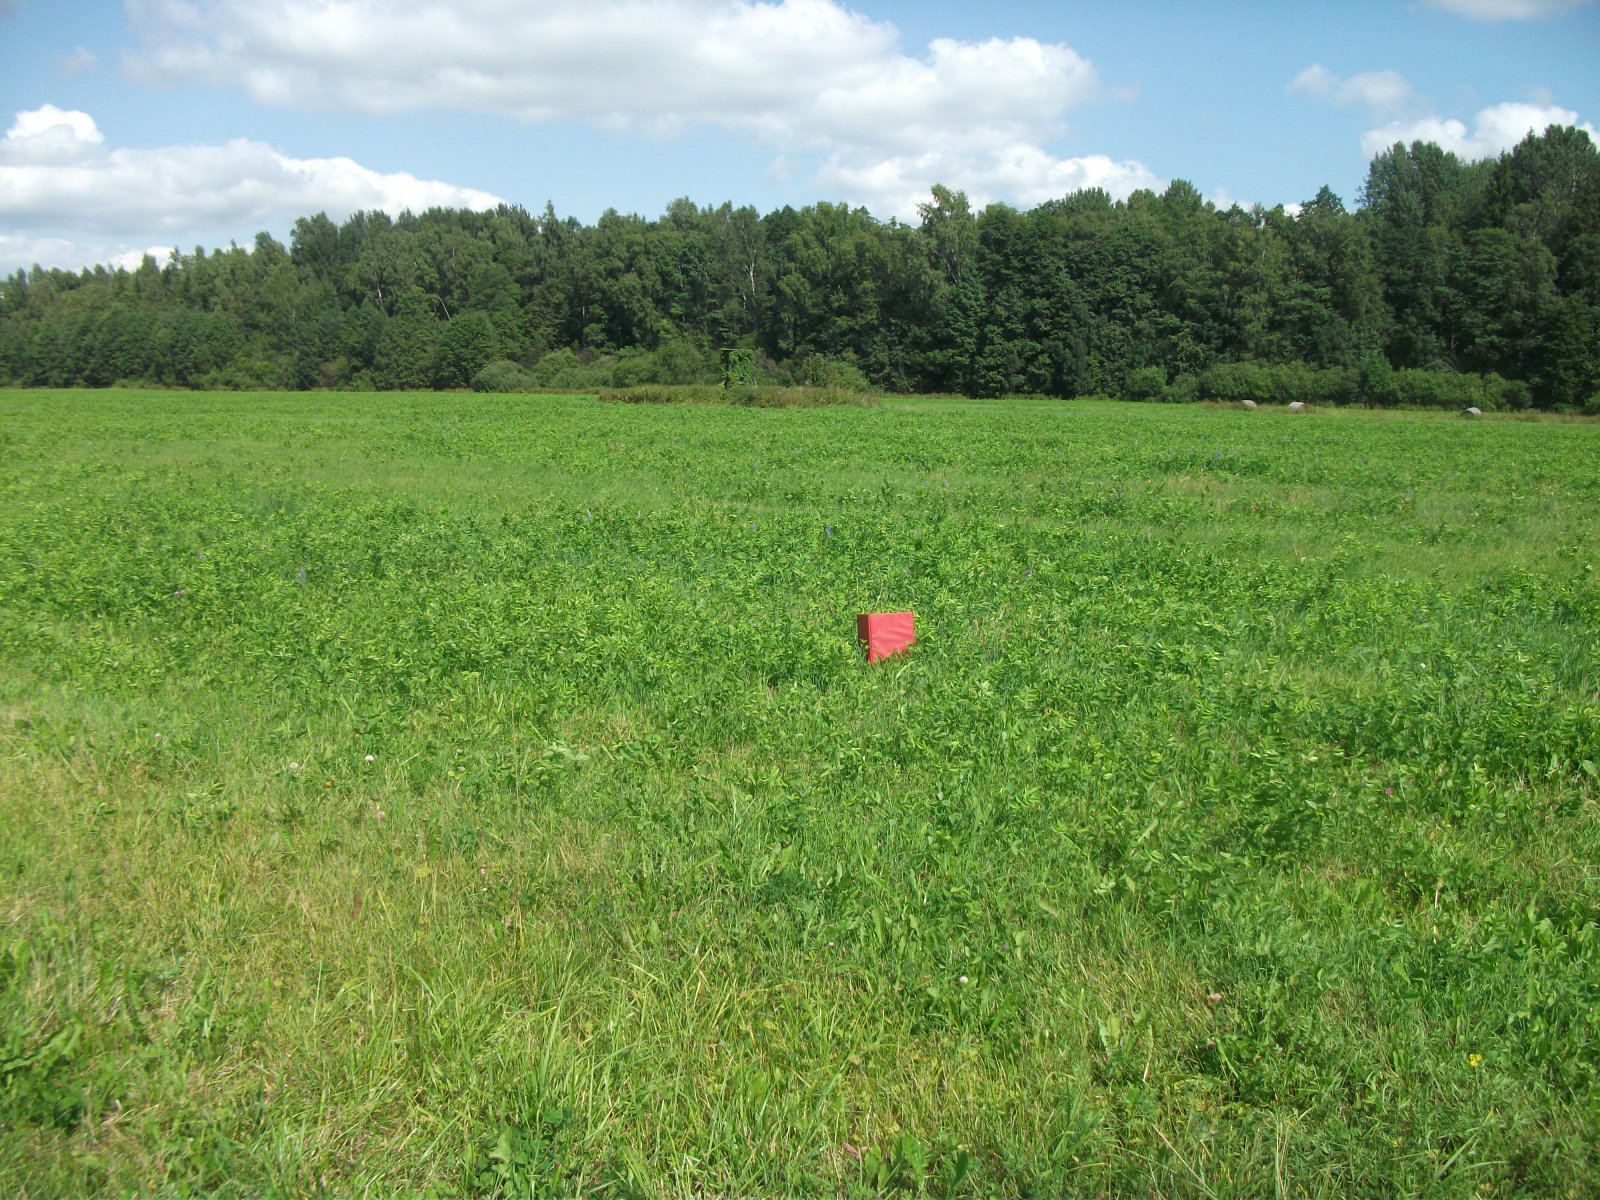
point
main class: Grassland
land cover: Grassland without tree/shrub cover
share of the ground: > 75 %
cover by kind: herbaceous plants 100 %
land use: Agriculture (excluding fallow land and kitchen gardens)
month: August
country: LV
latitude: 56.8912
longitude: 26.3765
